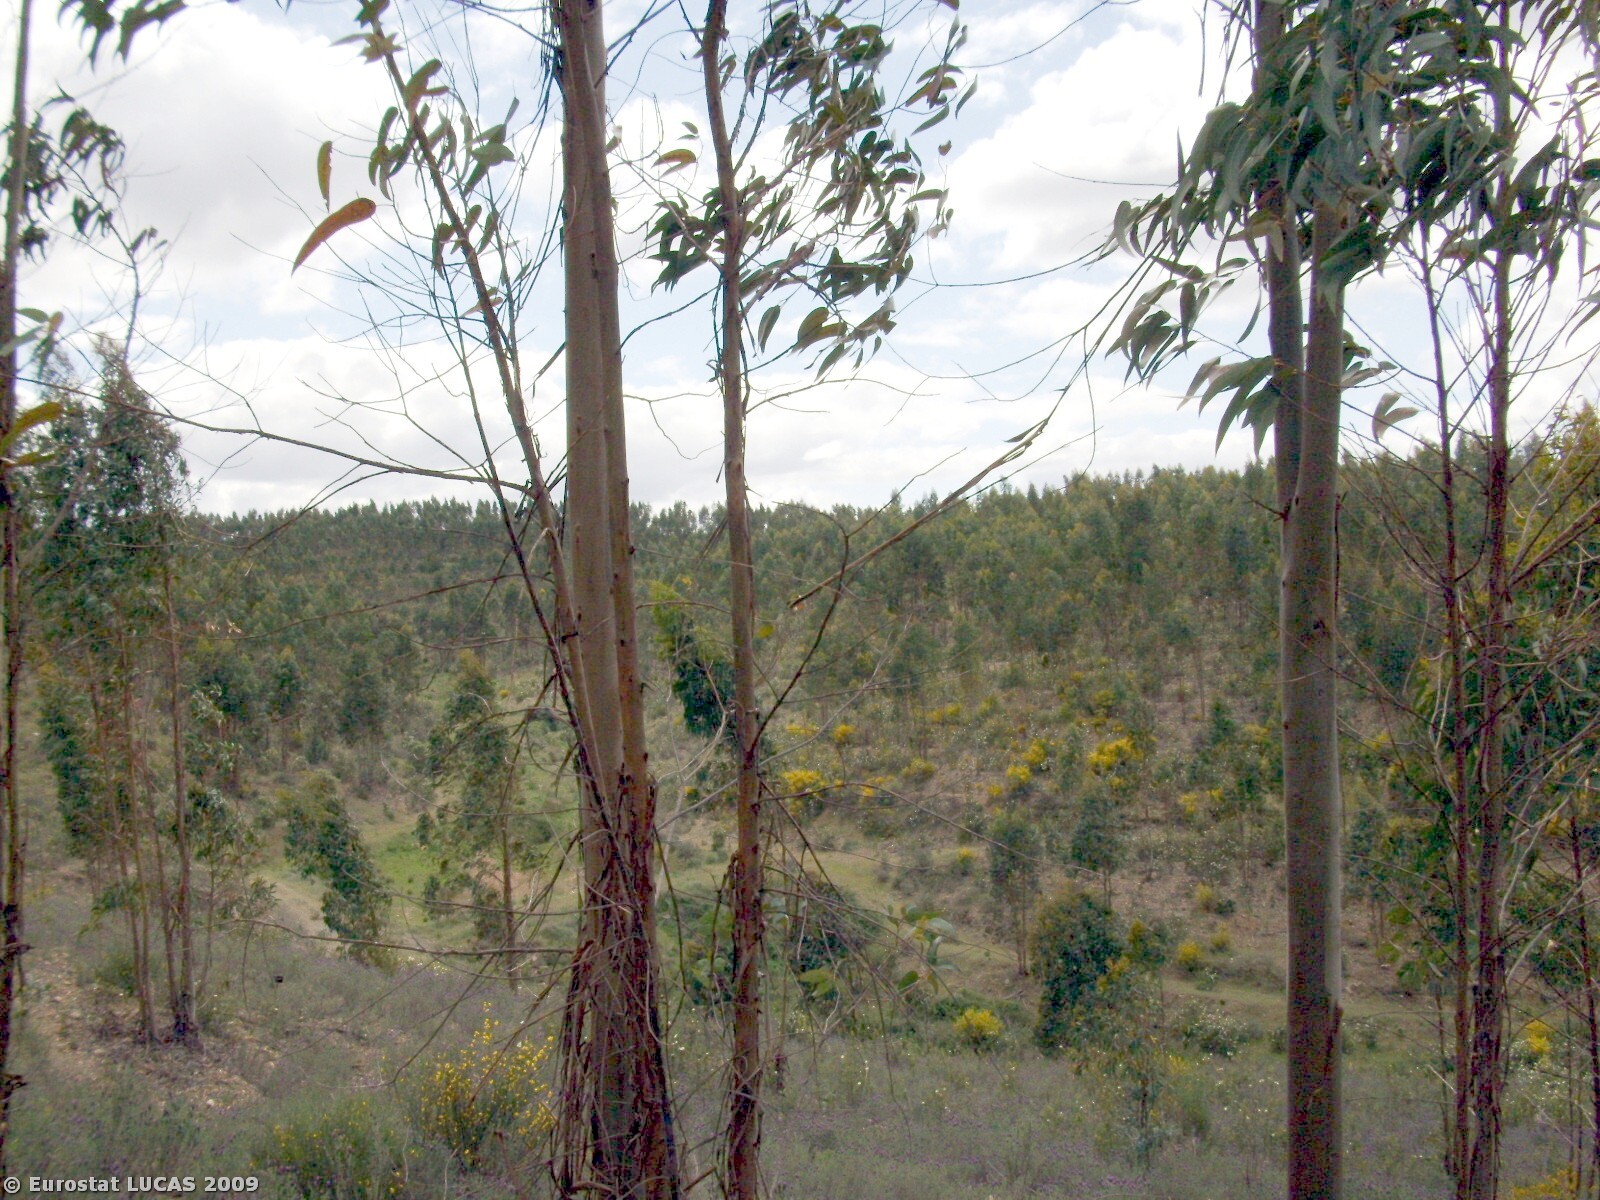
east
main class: Woodland
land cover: Broadleaved woodland
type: plantations and self-sown exotic forest
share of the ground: 50 - 75 %
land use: Forestry
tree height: > 5 m
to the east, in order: Broadleaved woodland; Tracks; Broadleaved woodland; Olive groves; Spontaneously vegetated surfaces; Tracks
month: April
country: PT
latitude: 39.6511
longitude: -7.5435
